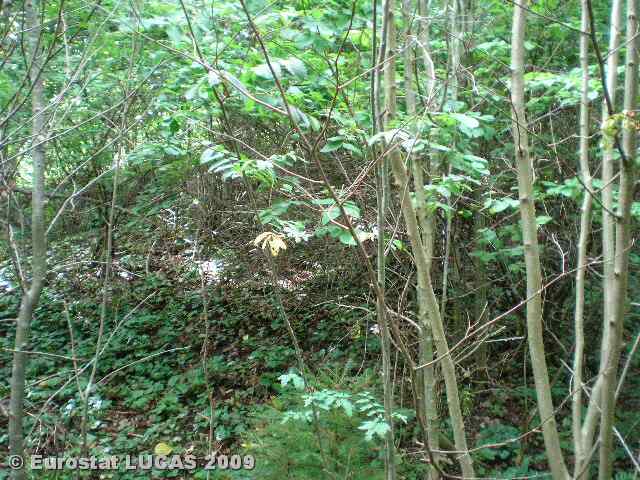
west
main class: Woodland
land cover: Broadleaved woodland
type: hemiboreal forest and nemoral coniferous forest and mixed broadleaved-coniferous forest
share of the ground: > 75 %
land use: Forestry
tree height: > 5 m
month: July
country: LT
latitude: 54.7024
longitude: 25.3781
